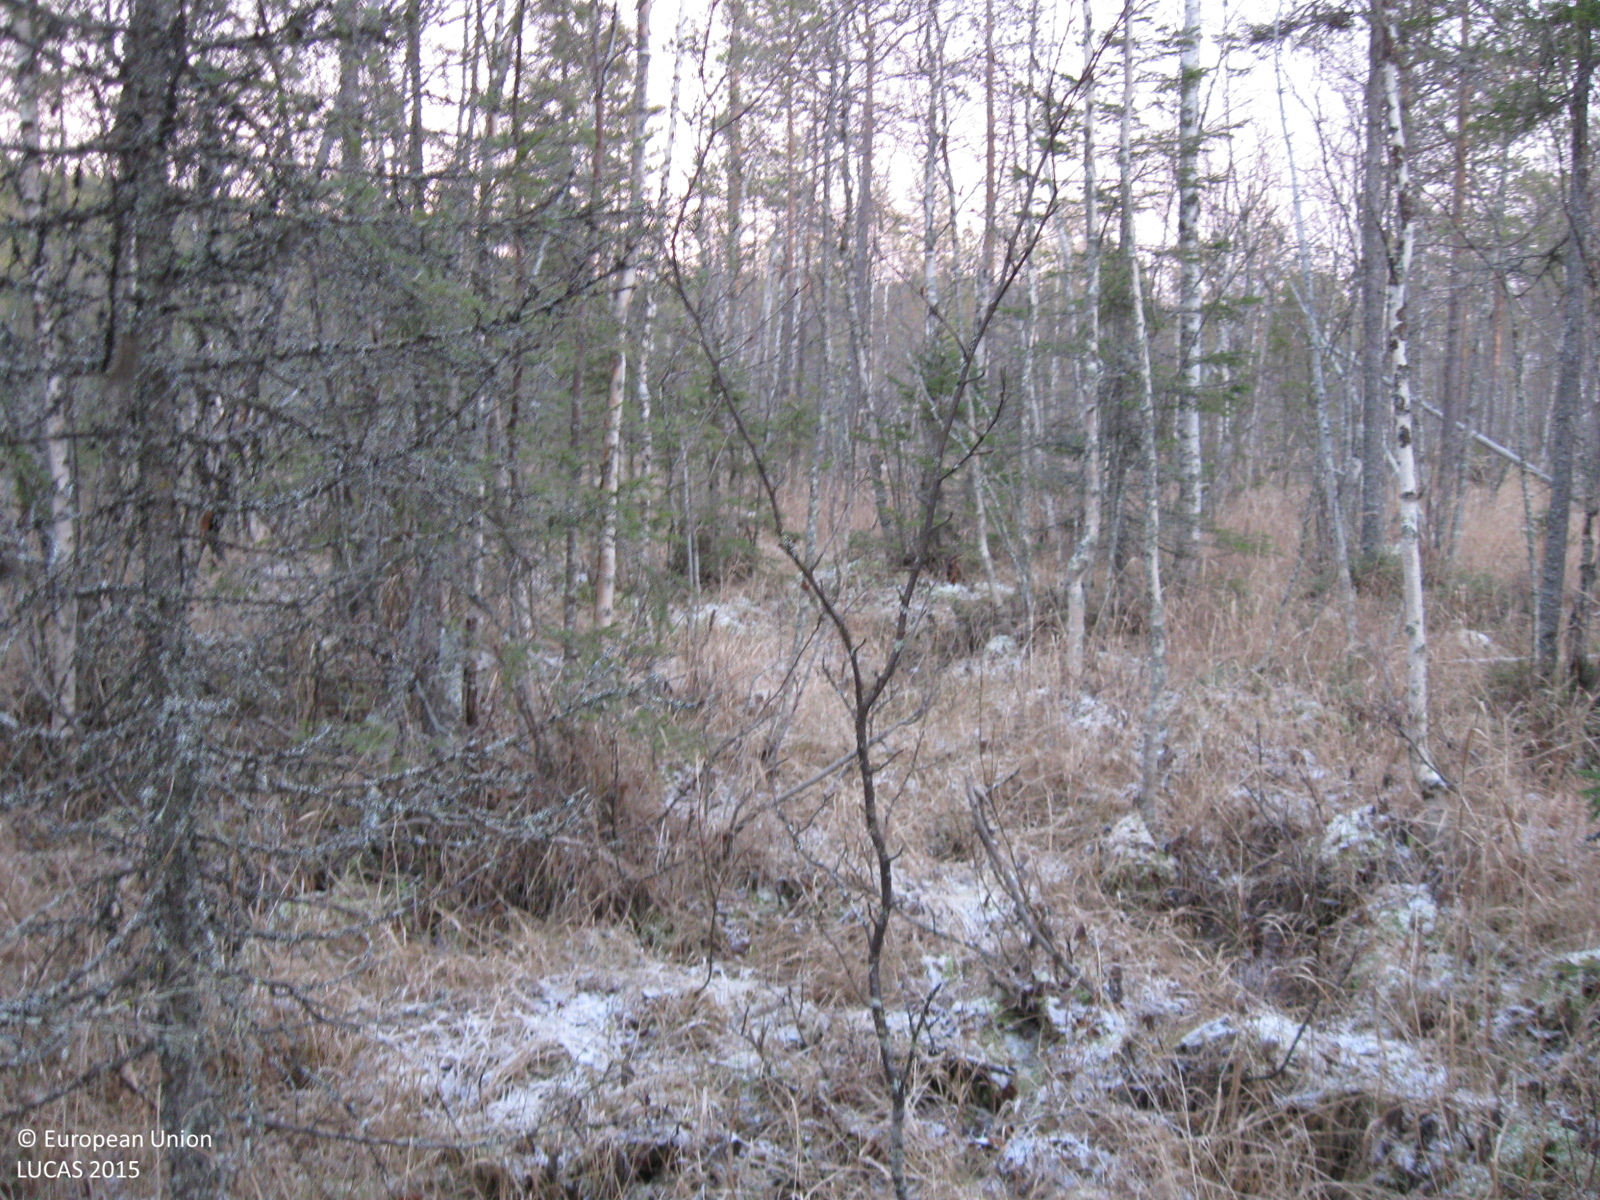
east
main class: Woodland
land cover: Spruce dominated mixed woodland
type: mire and swamp forests
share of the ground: 50 - 75 %
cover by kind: broadleaved forest trees 50 %, coniferous forest trees 20 %, herbaceous plants 20 %, shrubs 5 %, lichens and mosses 5 %
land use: Semi-natural and natural areas not in use
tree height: > 5 m
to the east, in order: Spruce dominated mixed woodland; Pine dominated mixed woodland; Pine dominated coniferous woodland; Peatbogs; Pine dominated coniferous woodland; Pine dominated mixed woodland
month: October
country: SE
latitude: 66.1680
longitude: 21.3433
